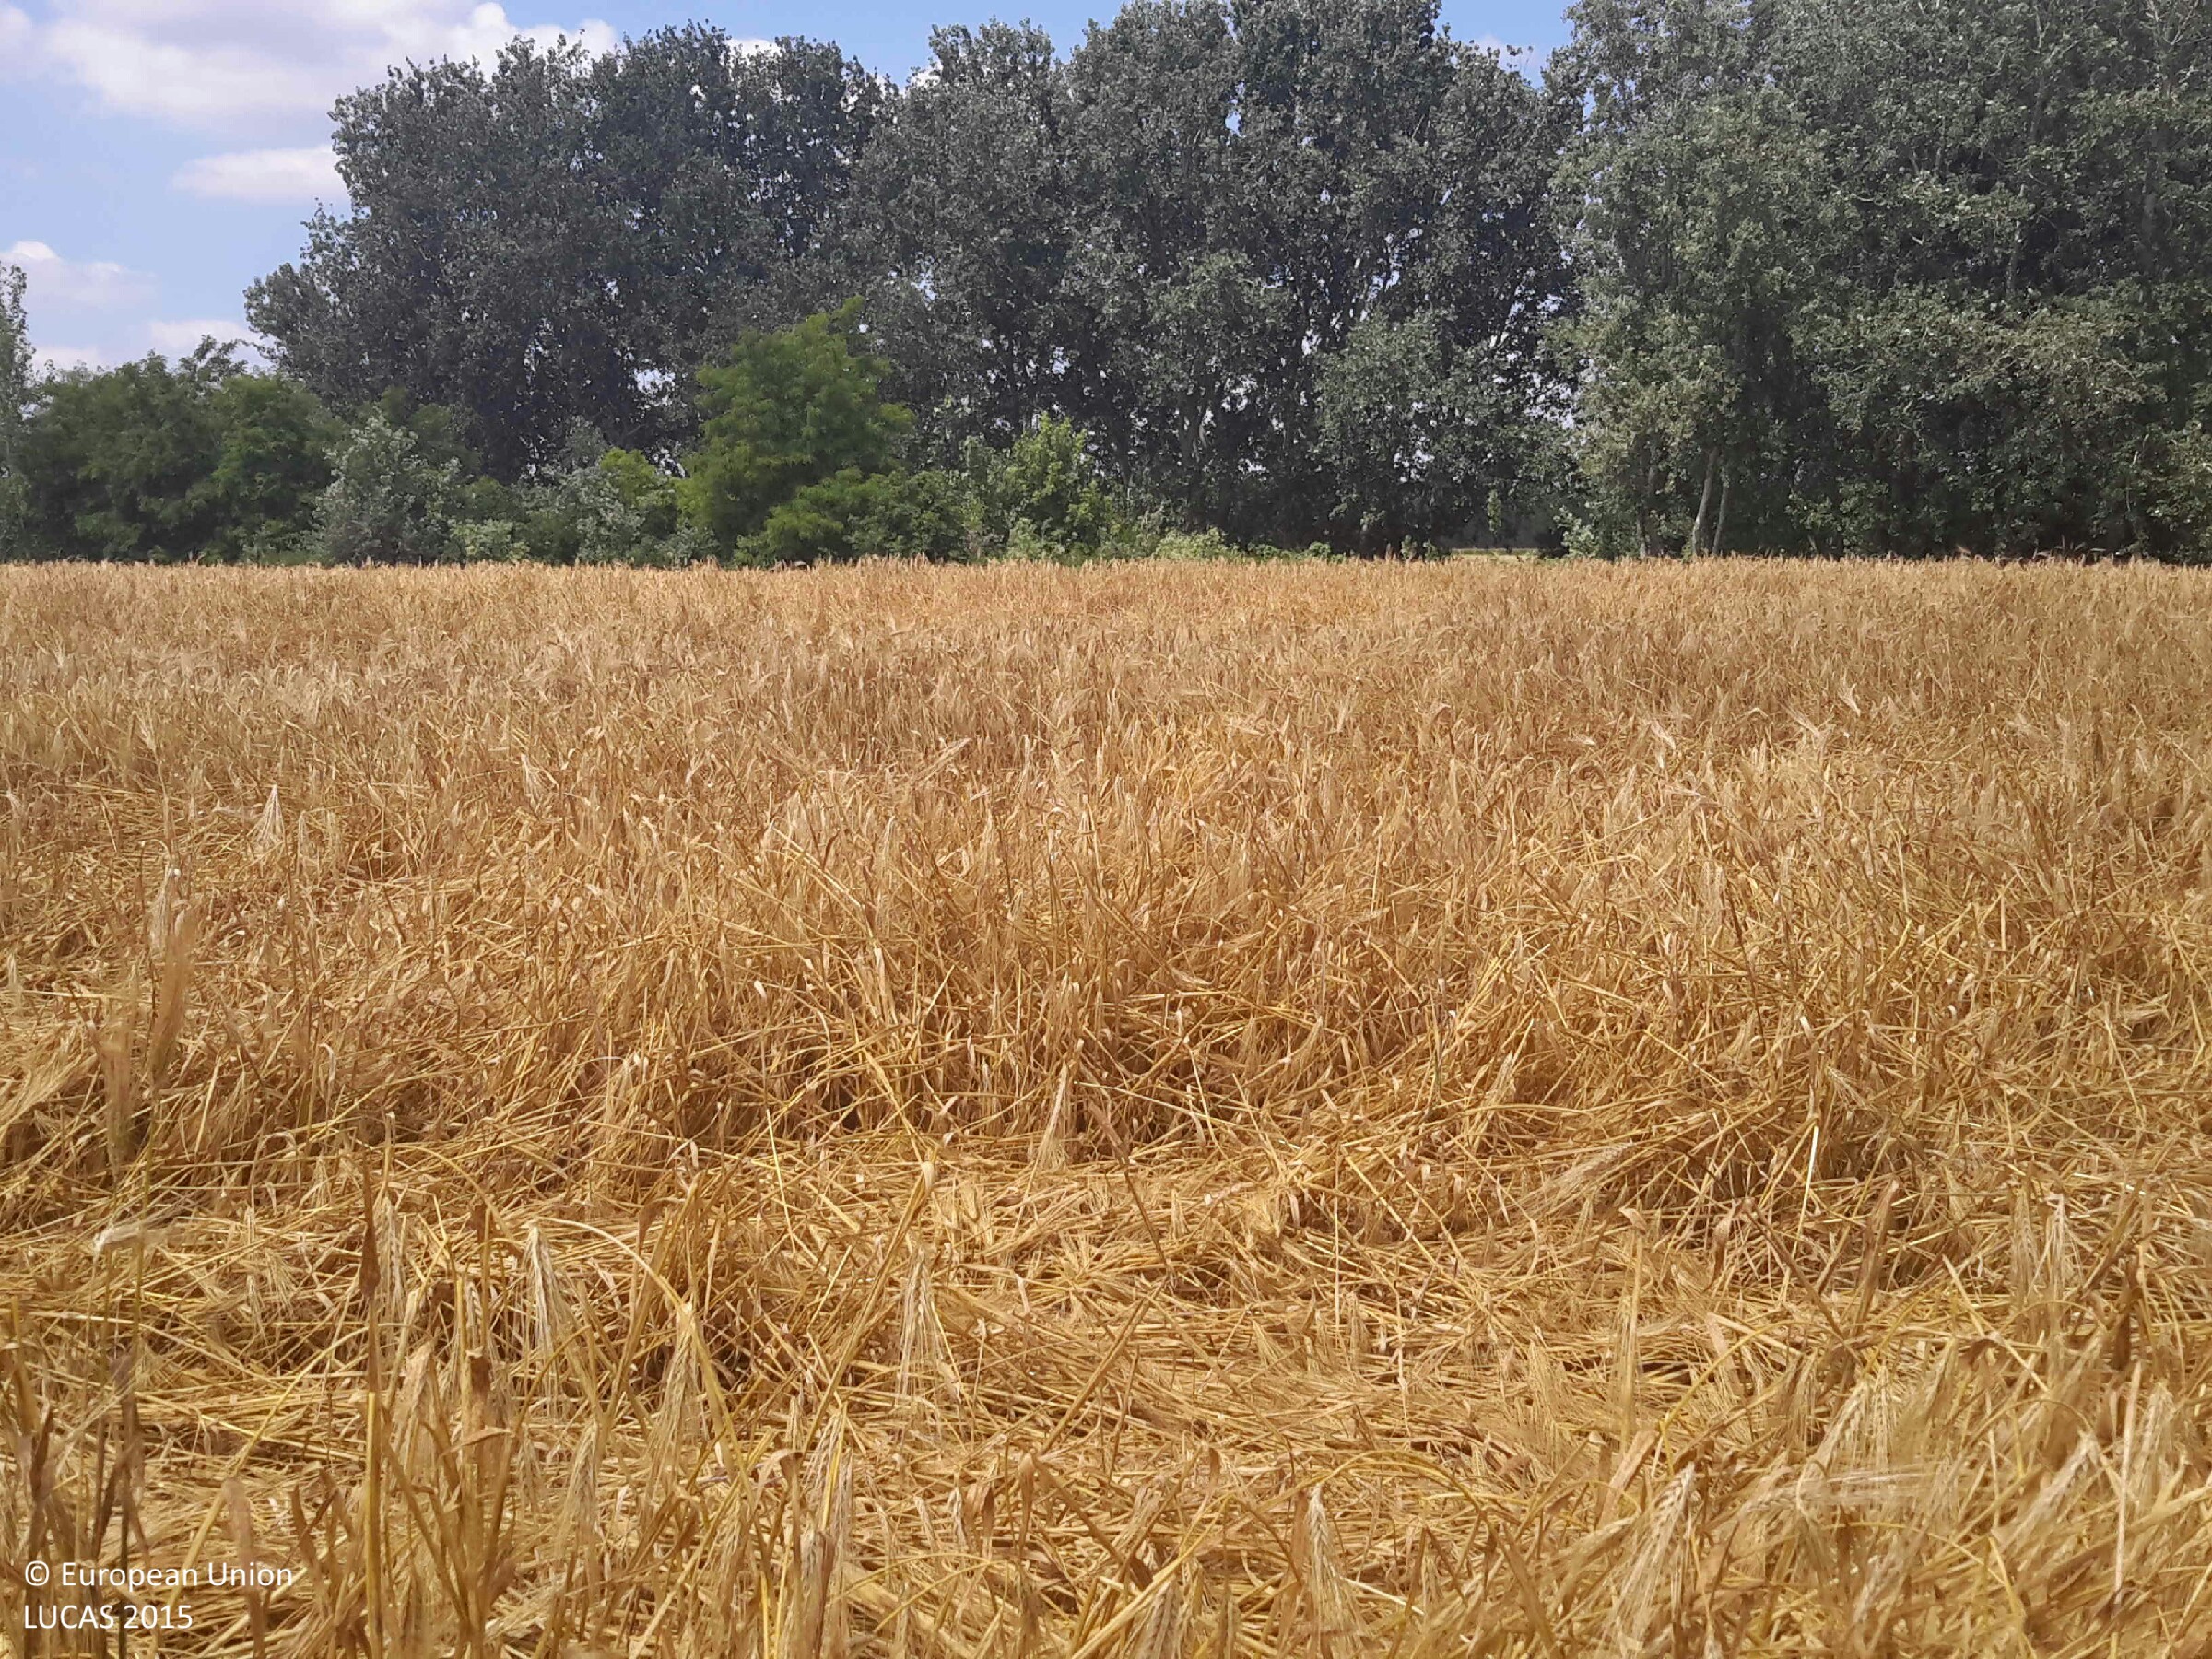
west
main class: Cropland
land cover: Barley
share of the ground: > 75 %
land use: Agriculture (excluding fallow land and kitchen gardens)
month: June
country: HU
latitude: 47.7497
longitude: 17.5184
